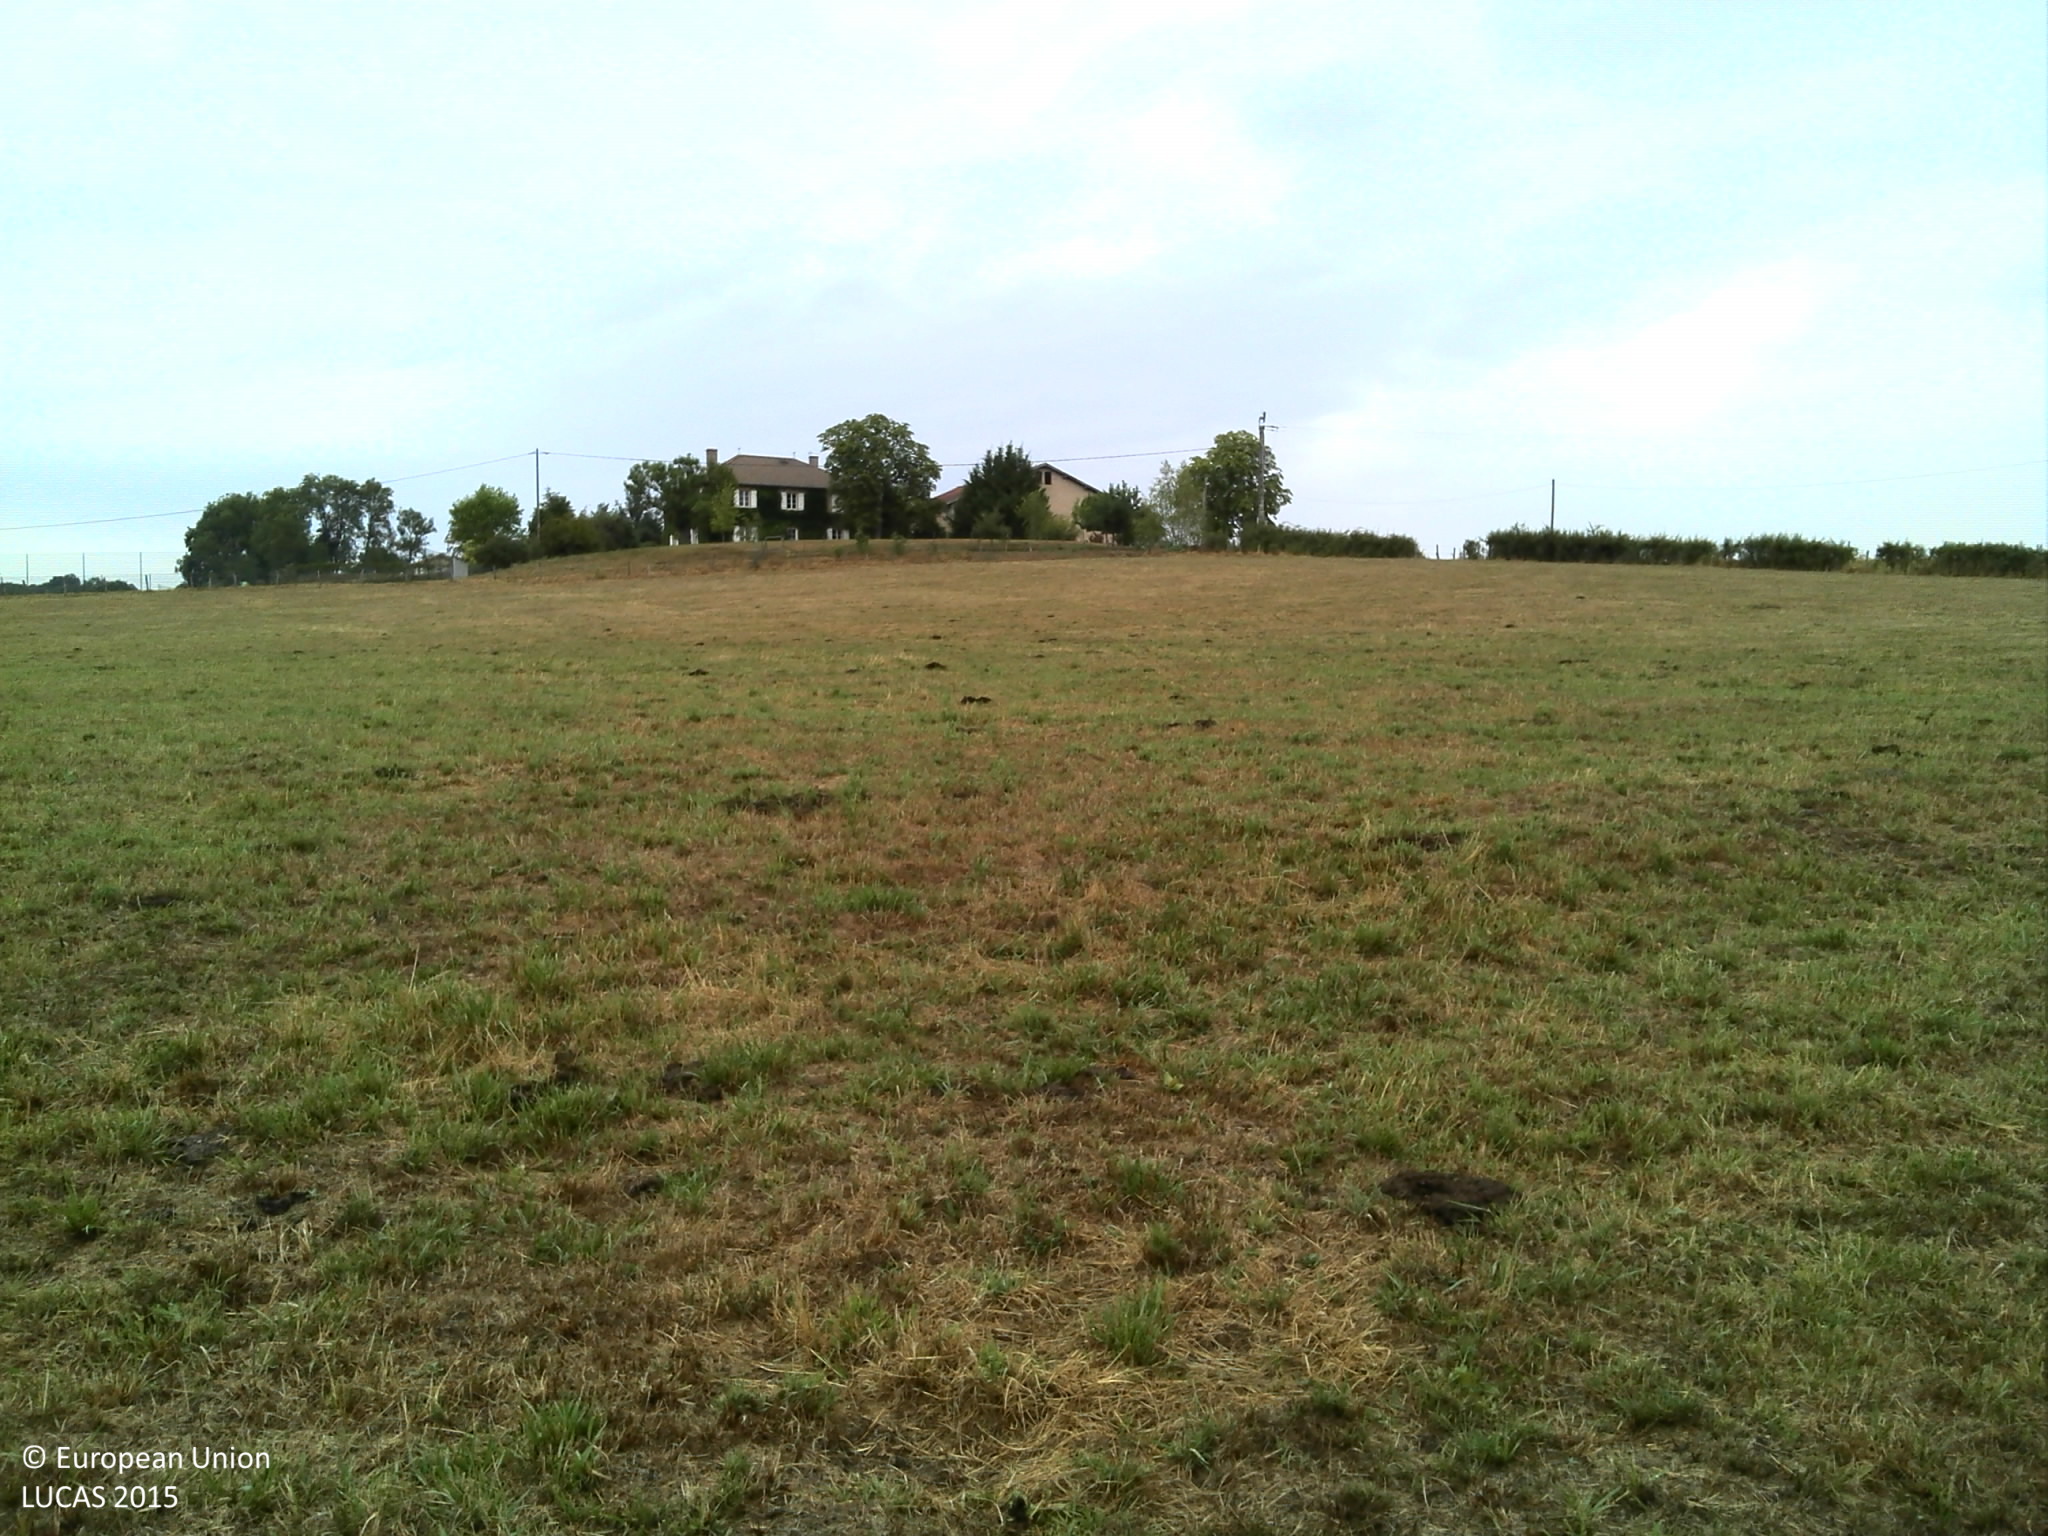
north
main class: Grassland
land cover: Grassland without tree/shrub cover
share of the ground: > 75 %
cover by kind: herbaceous plants 100 %
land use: Agriculture (excluding fallow land and kitchen gardens)
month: August
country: FR
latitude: 46.1485
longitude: 4.0326
